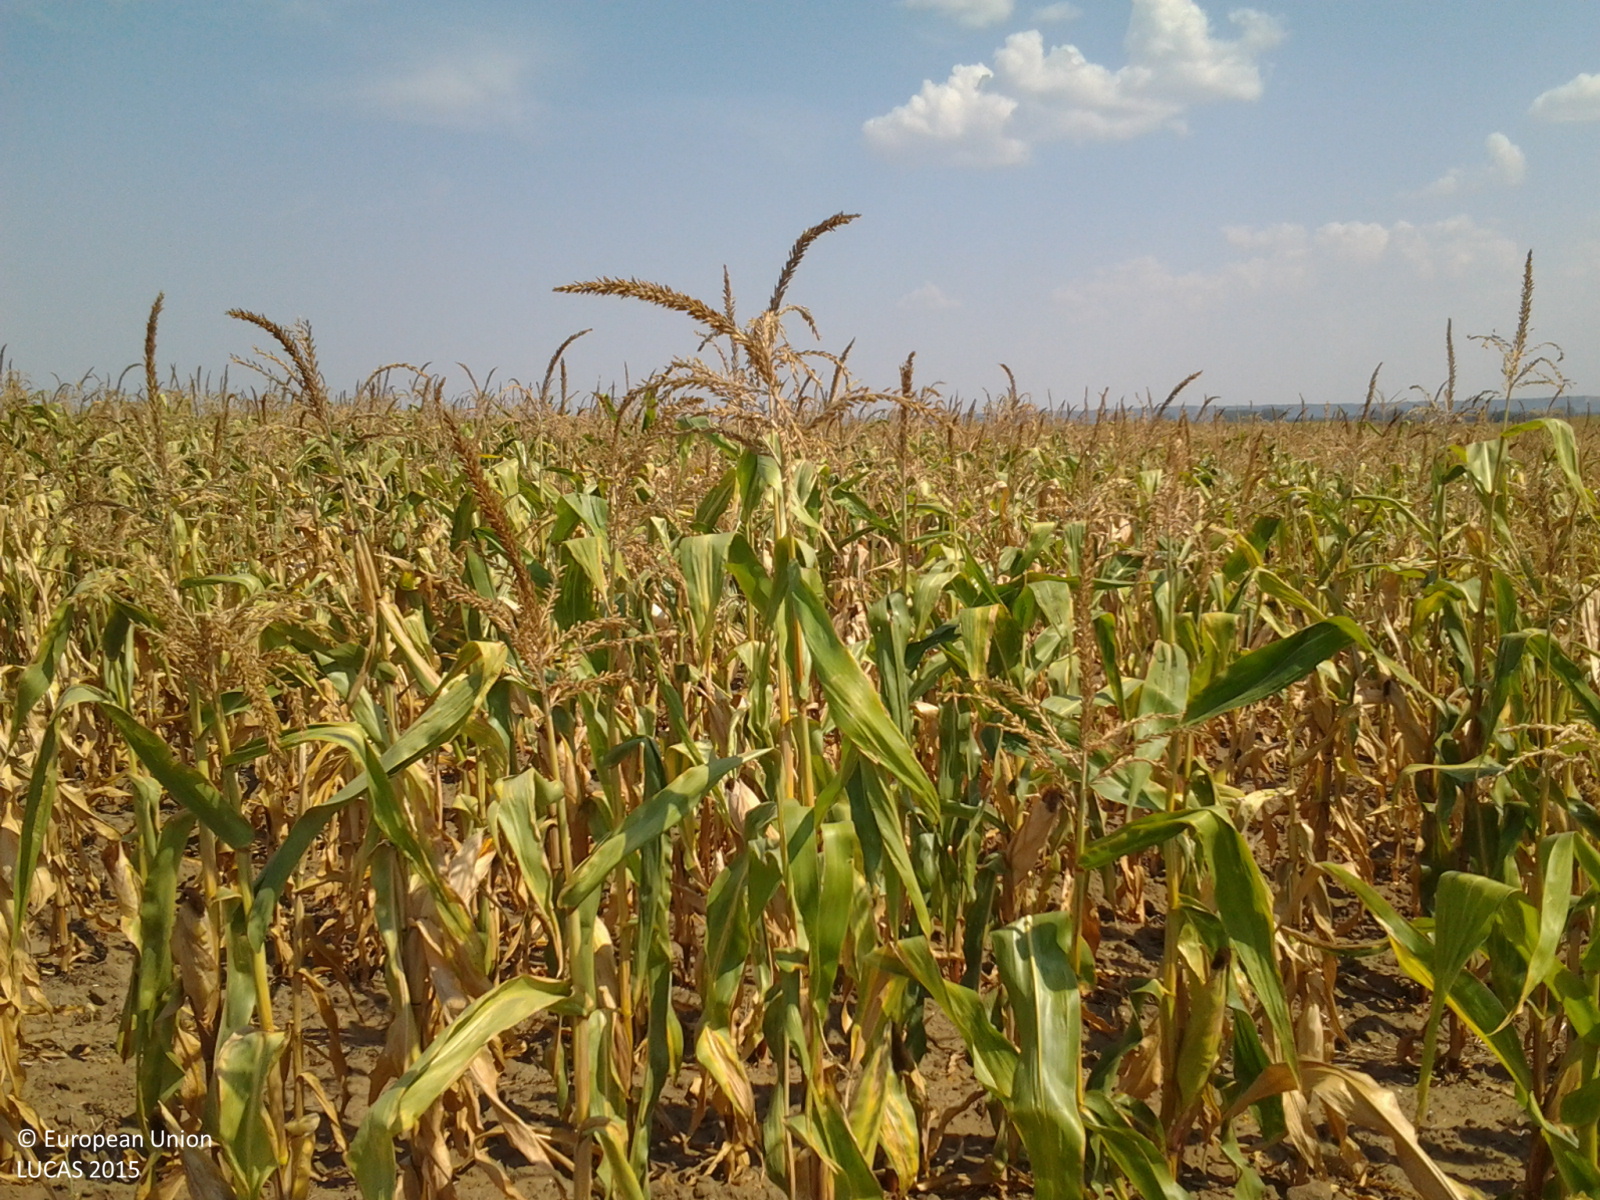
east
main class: Cropland
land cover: Maize
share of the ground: > 75 %
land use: Agriculture (excluding fallow land and kitchen gardens)
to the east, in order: Maize; Common wheat; Maize
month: August
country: RO
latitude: 43.8345
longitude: 23.0366
